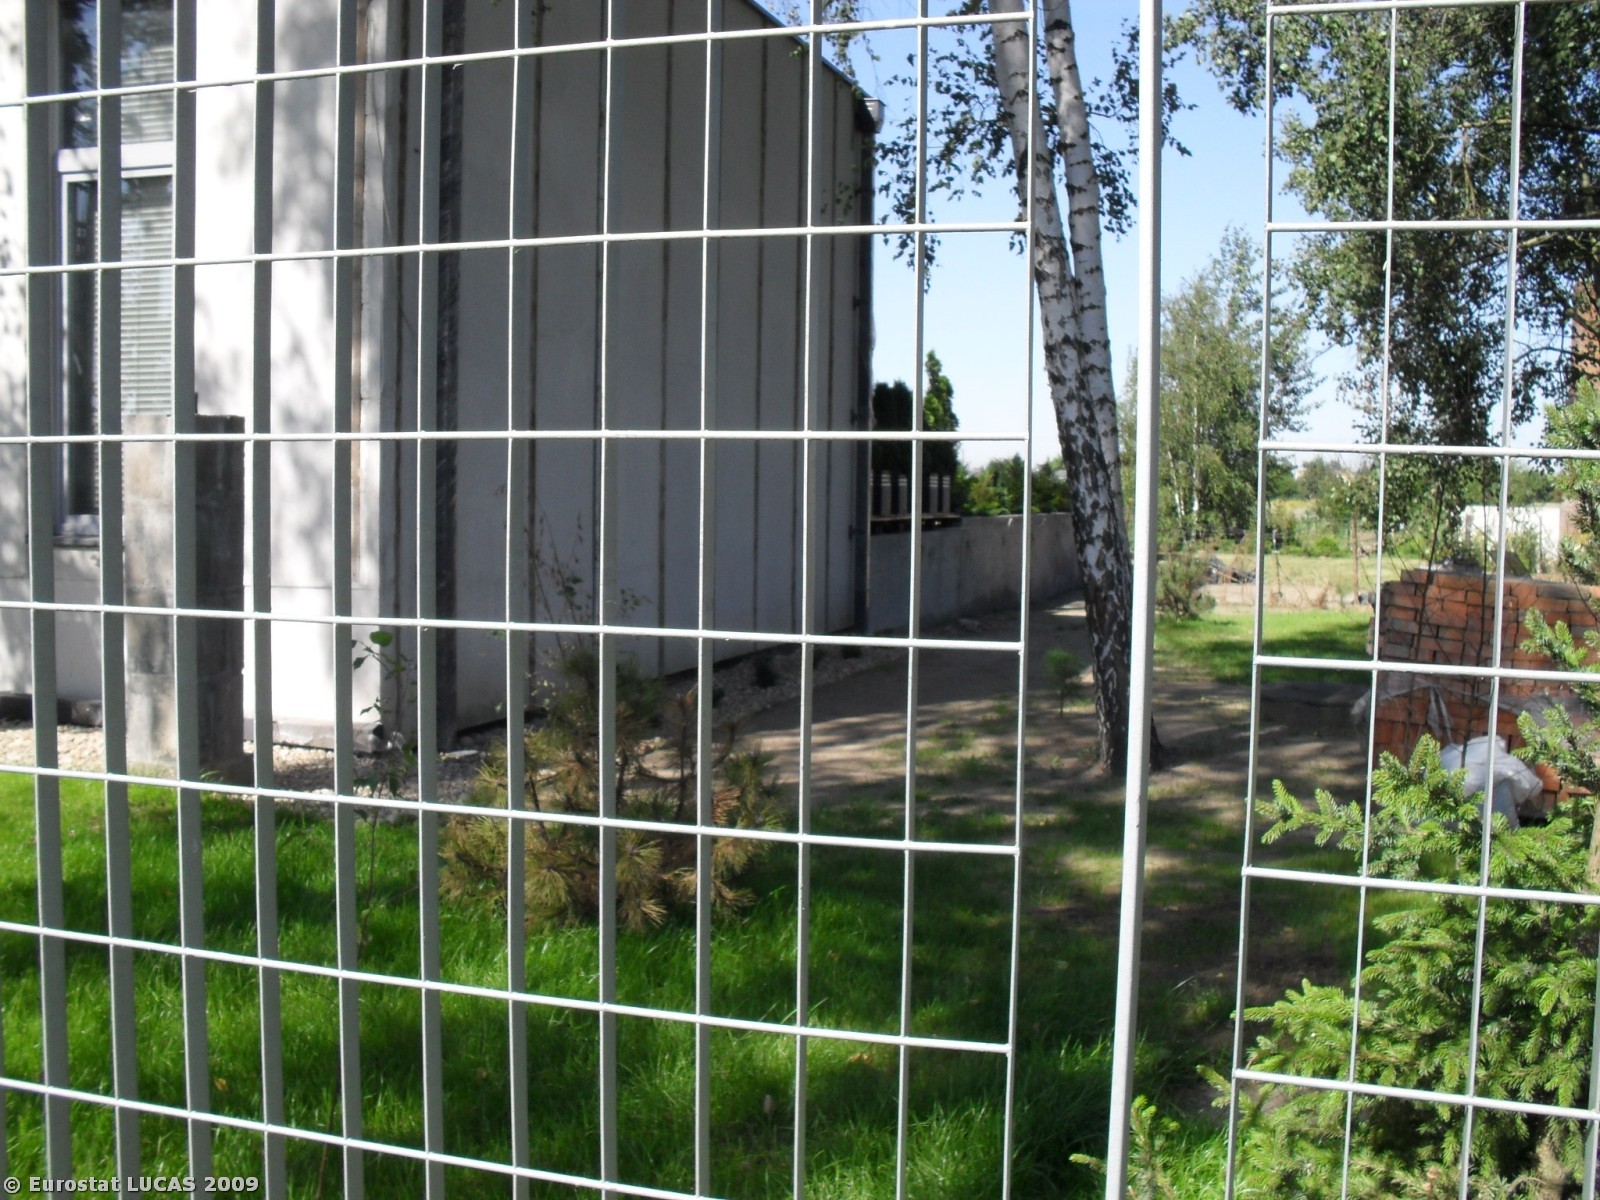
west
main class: Grassland
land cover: Grassland with sparse tree/shrub cover
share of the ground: > 75 %
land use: Residential
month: August
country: PL
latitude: 51.6769
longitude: 19.4127
